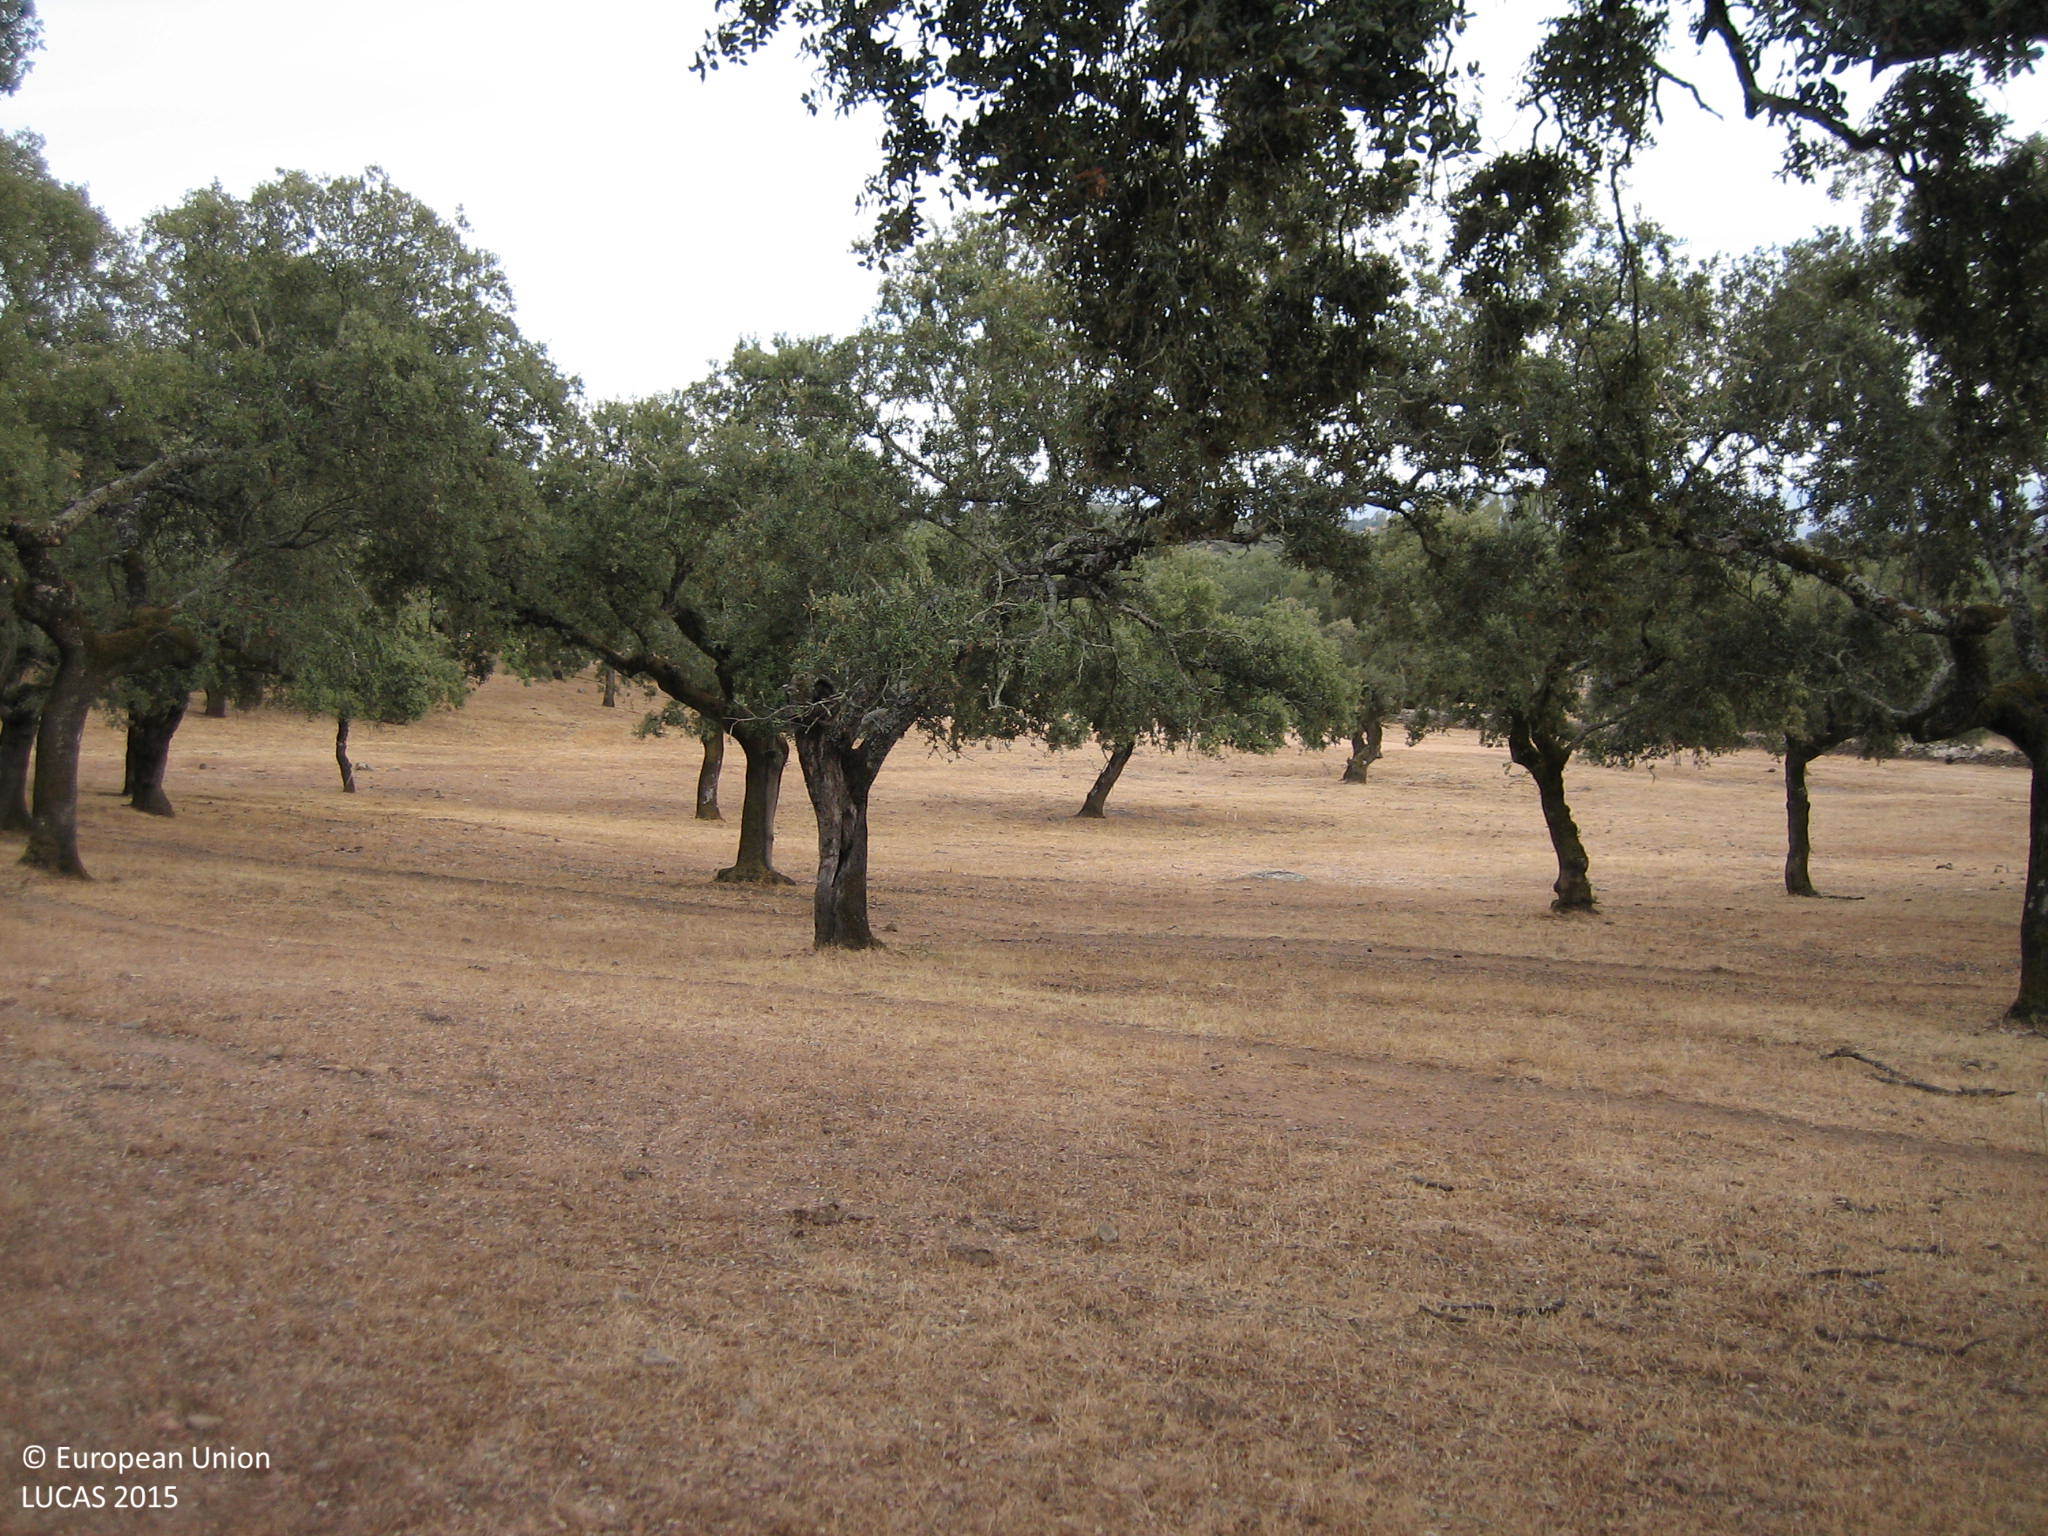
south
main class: Woodland
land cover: Broadleaved woodland
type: broadleaved evergreen forest
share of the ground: 25 - 50 %
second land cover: Grassland without tree/shrub cover
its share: > 75 %
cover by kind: herbaceous plants 60 %, broadleaved forest trees 40 %
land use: Forestry
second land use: Agriculture (excluding fallow land and kitchen gardens)
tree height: > 5 m
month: September
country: ES
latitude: 38.3465
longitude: -6.7962
